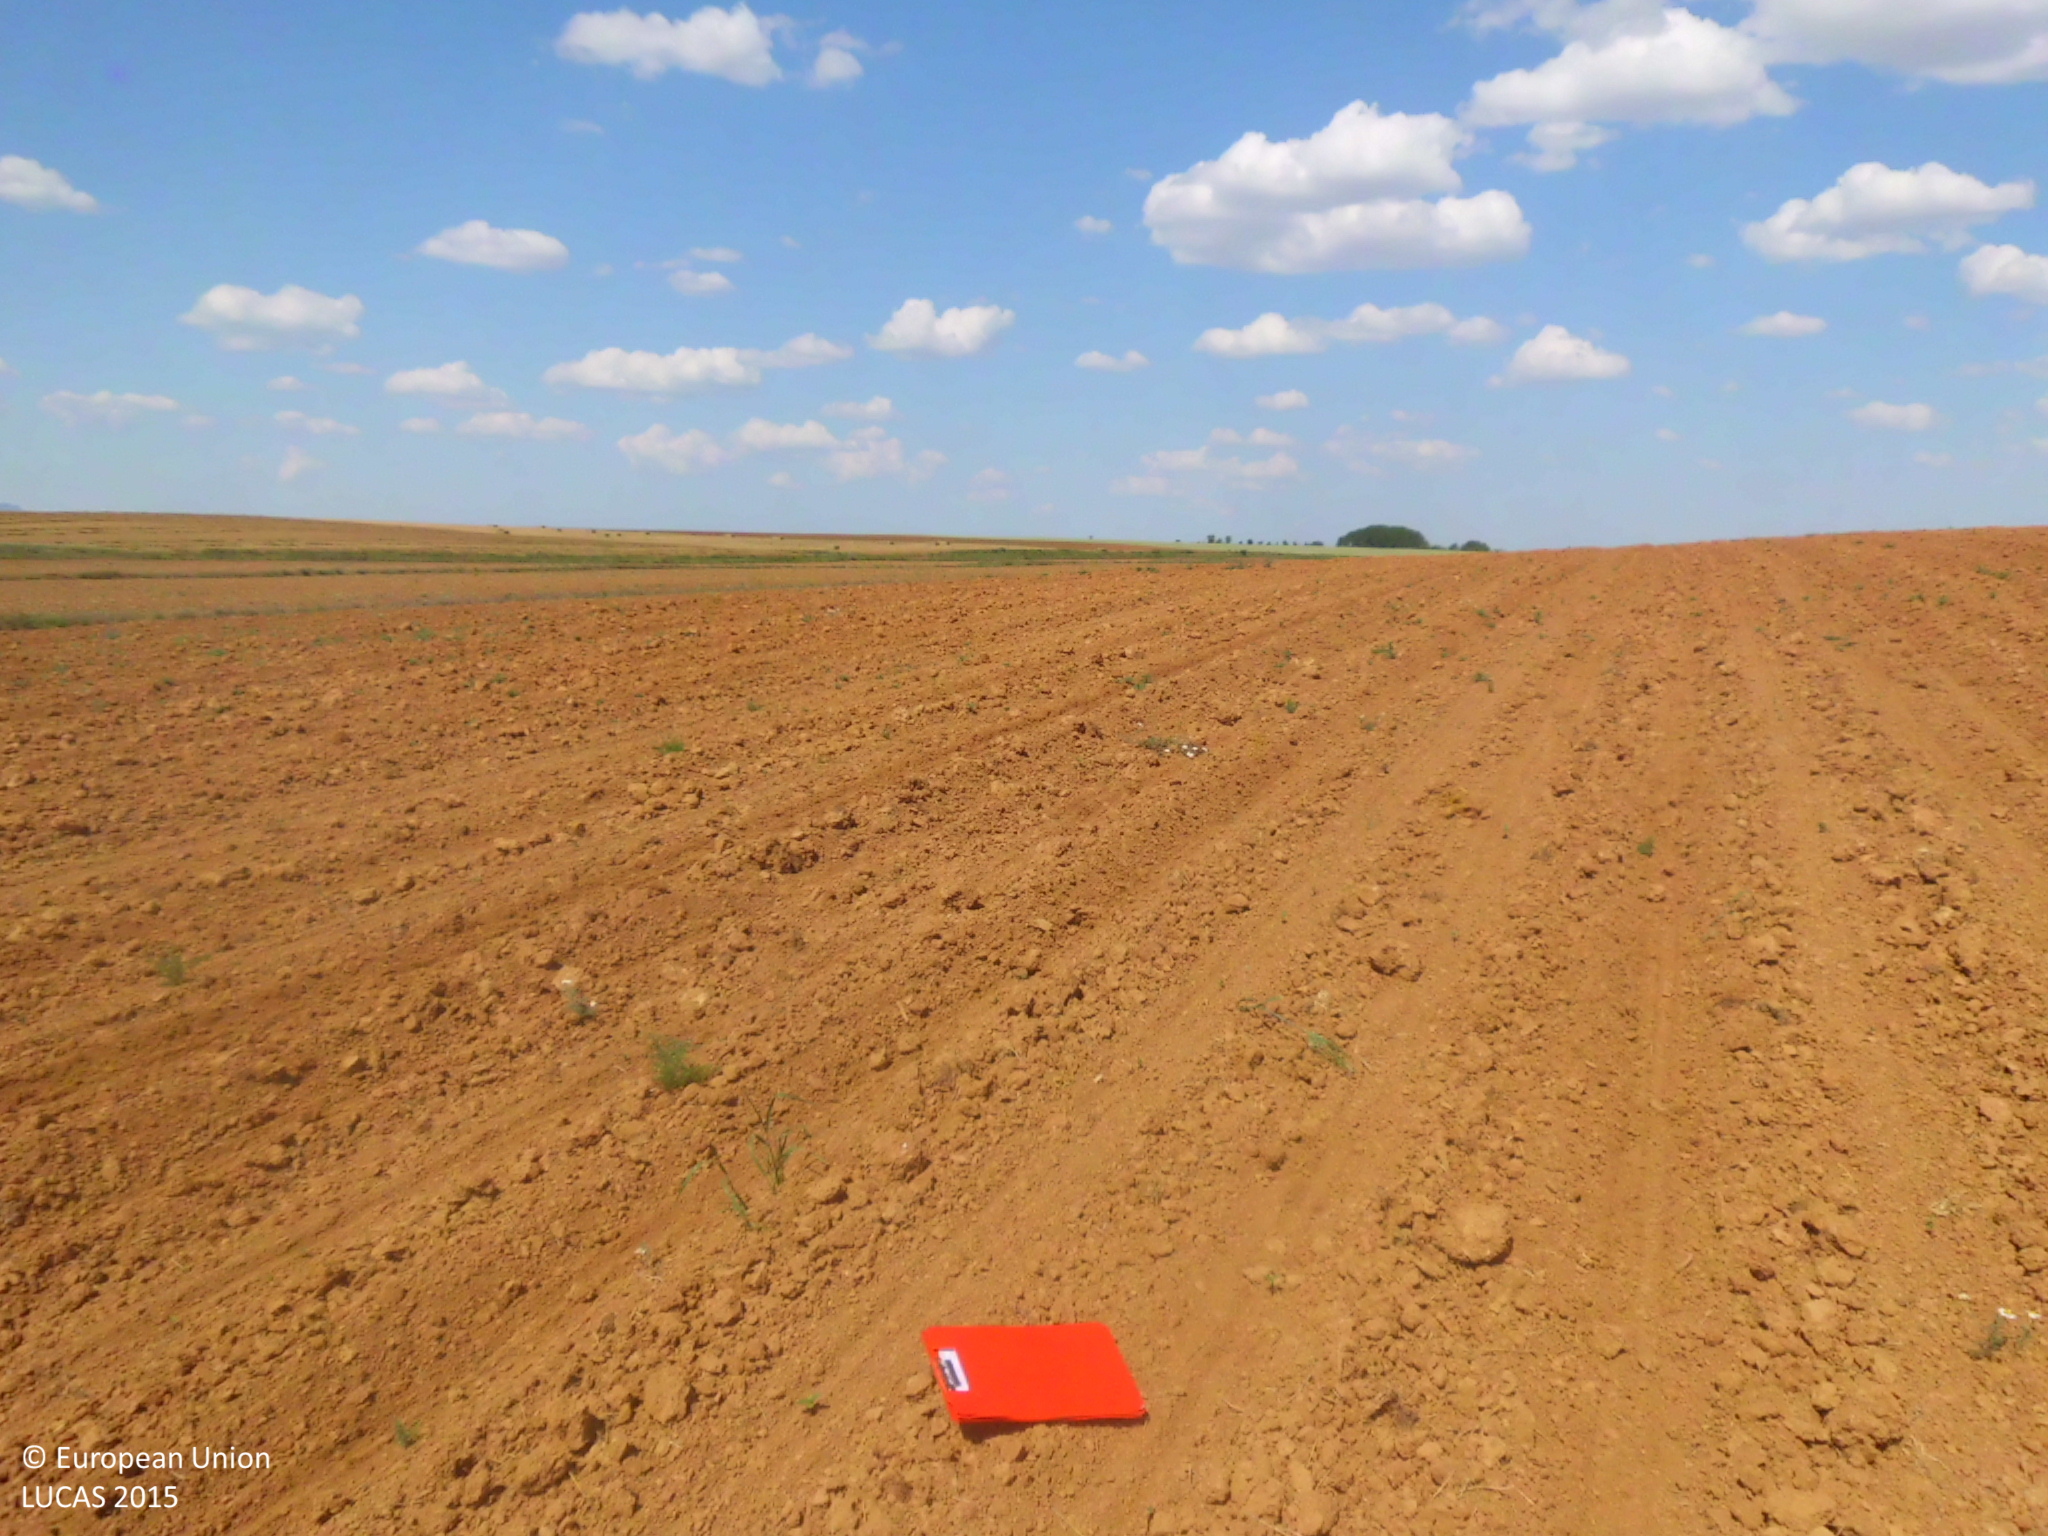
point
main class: Cropland
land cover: Sunflower
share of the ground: < 10 %
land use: Agriculture (excluding fallow land and kitchen gardens)
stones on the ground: < 10 %
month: June
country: ES
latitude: 42.4340
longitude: -4.2068
